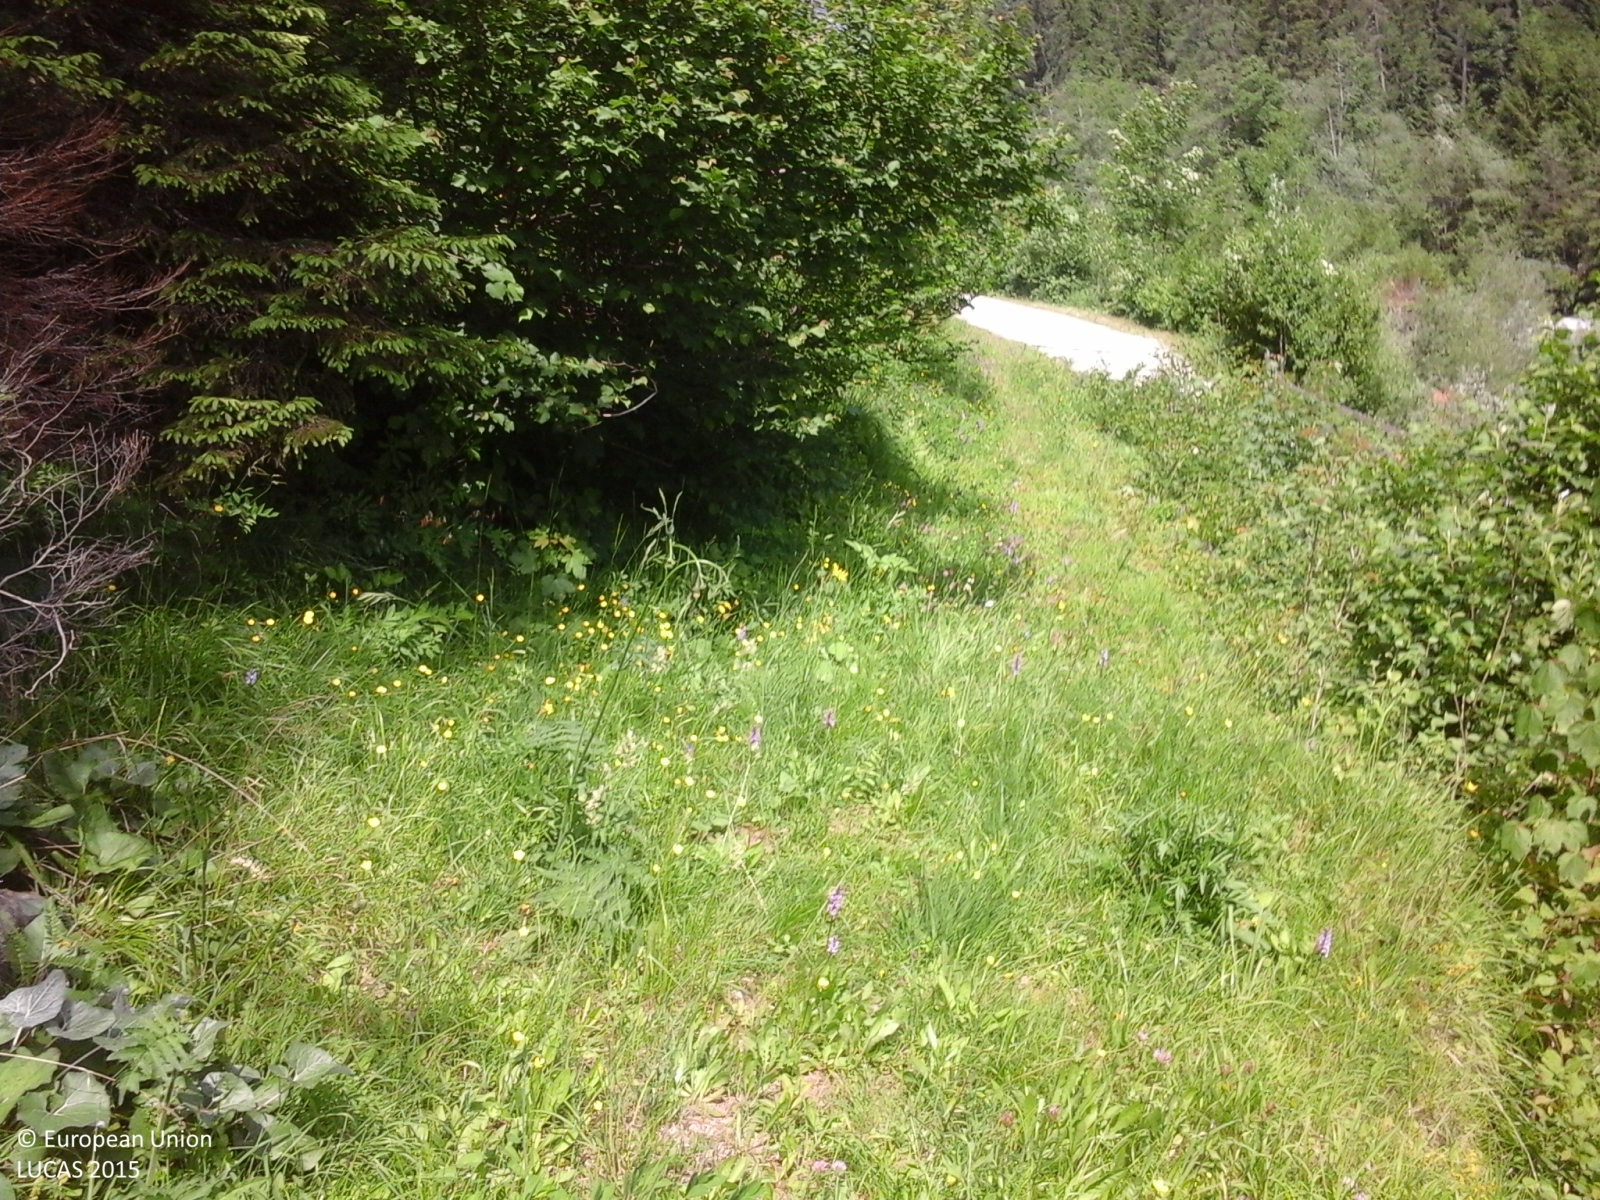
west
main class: Woodland
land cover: Spruce dominated mixed woodland
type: alpine coniferous forest
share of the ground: > 75 %
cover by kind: coniferous forest trees 75 %, broadleaved forest trees 25 %
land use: Semi-natural and natural areas not in use
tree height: > 5 m
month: June
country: IT
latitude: 46.4509
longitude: 12.3797
